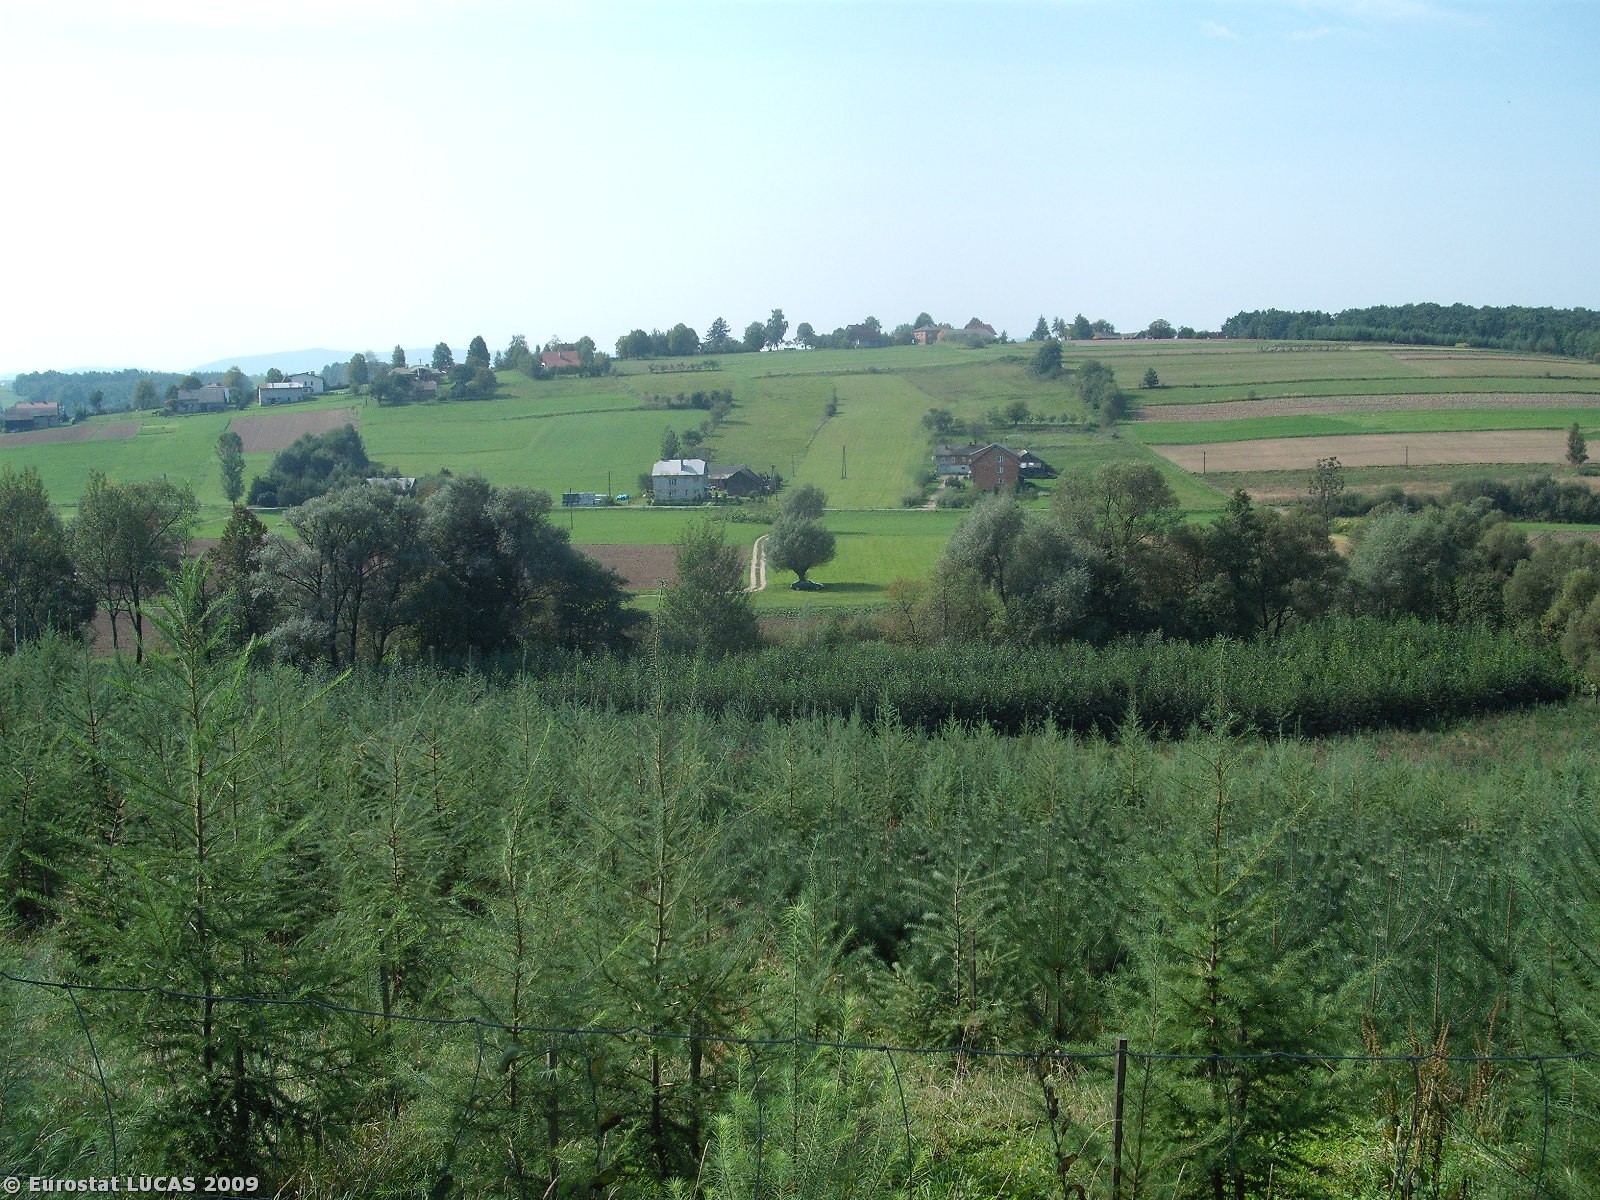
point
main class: Woodland
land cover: Coniferous woodland
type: hemiboreal forest and nemoral coniferous forest and mixed broadleaved-coniferous forest
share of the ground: 50 - 75 %
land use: Agriculture (excluding fallow land and kitchen gardens)
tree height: > 5 m
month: September
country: PL
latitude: 49.7213
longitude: 21.0153
